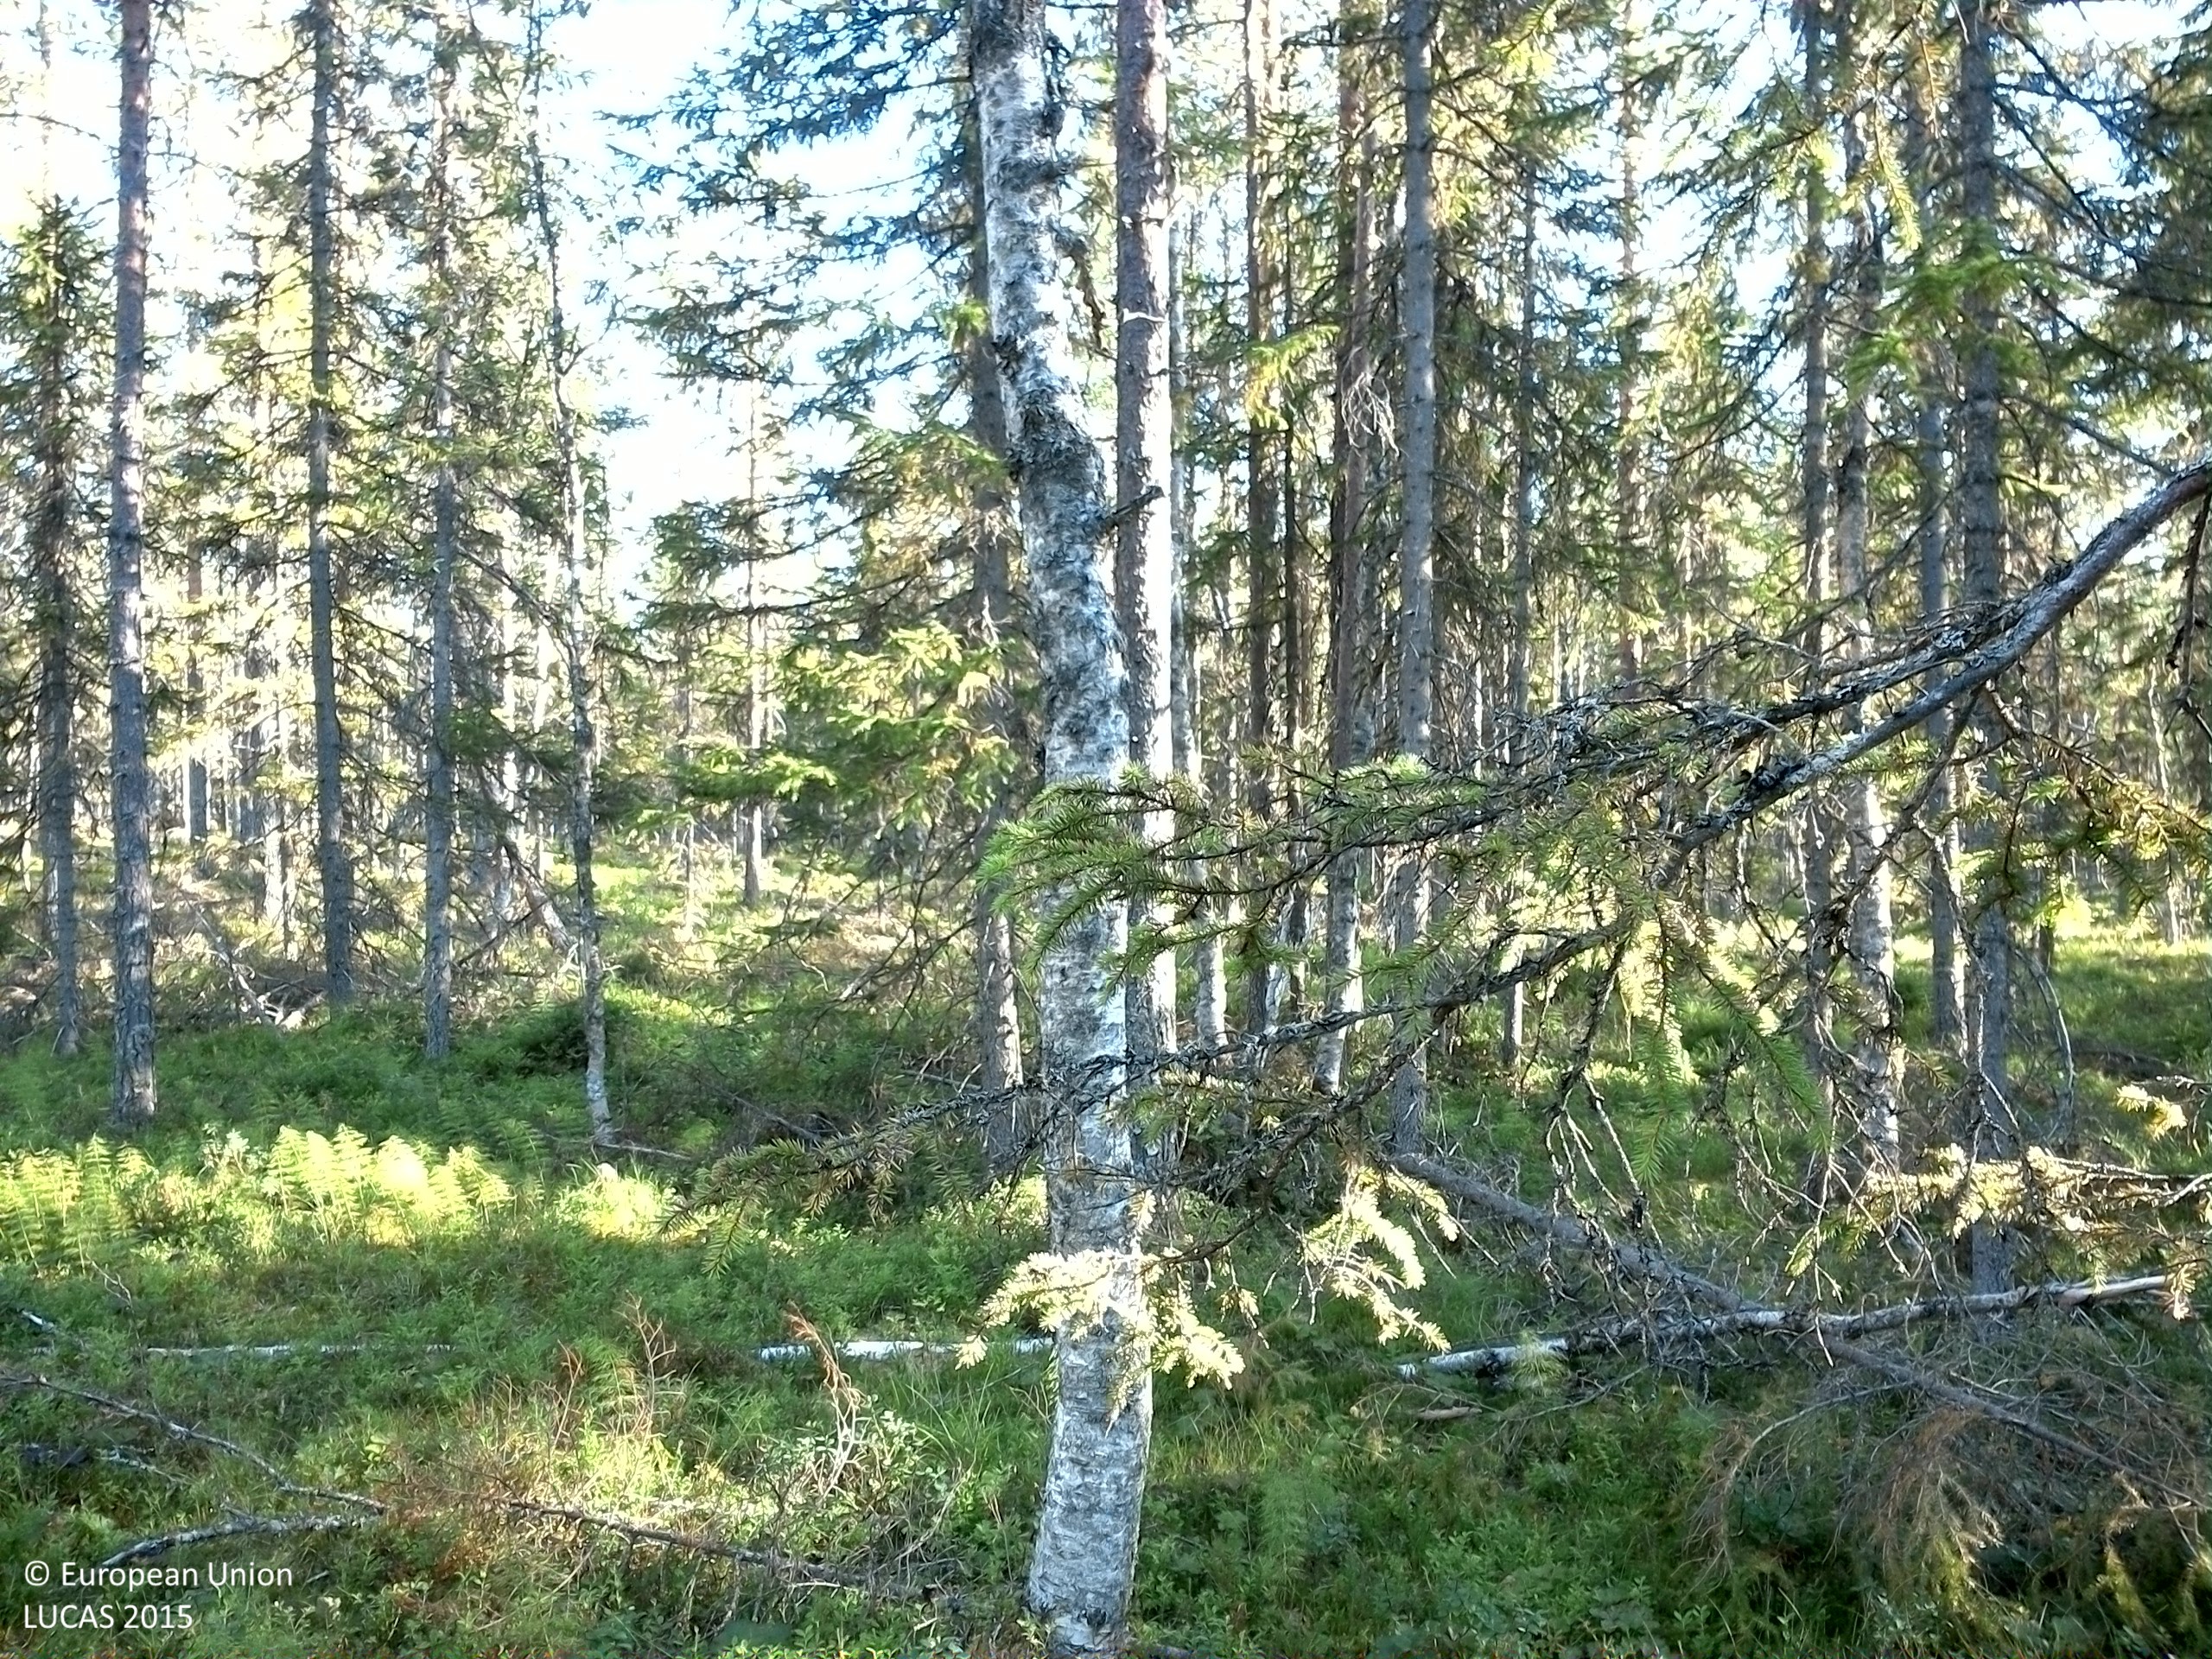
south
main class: Woodland
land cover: Pine dominated coniferous woodland
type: boreal forest
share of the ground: 50 - 75 %
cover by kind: coniferous forest trees 60 %, shrubs 25 %, broadleaved forest trees 5 %, herbaceous plants 5 %, lichens and mosses 5 %
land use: Forestry
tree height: > 5 m
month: August
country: SE
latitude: 63.6918
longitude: 17.5566
